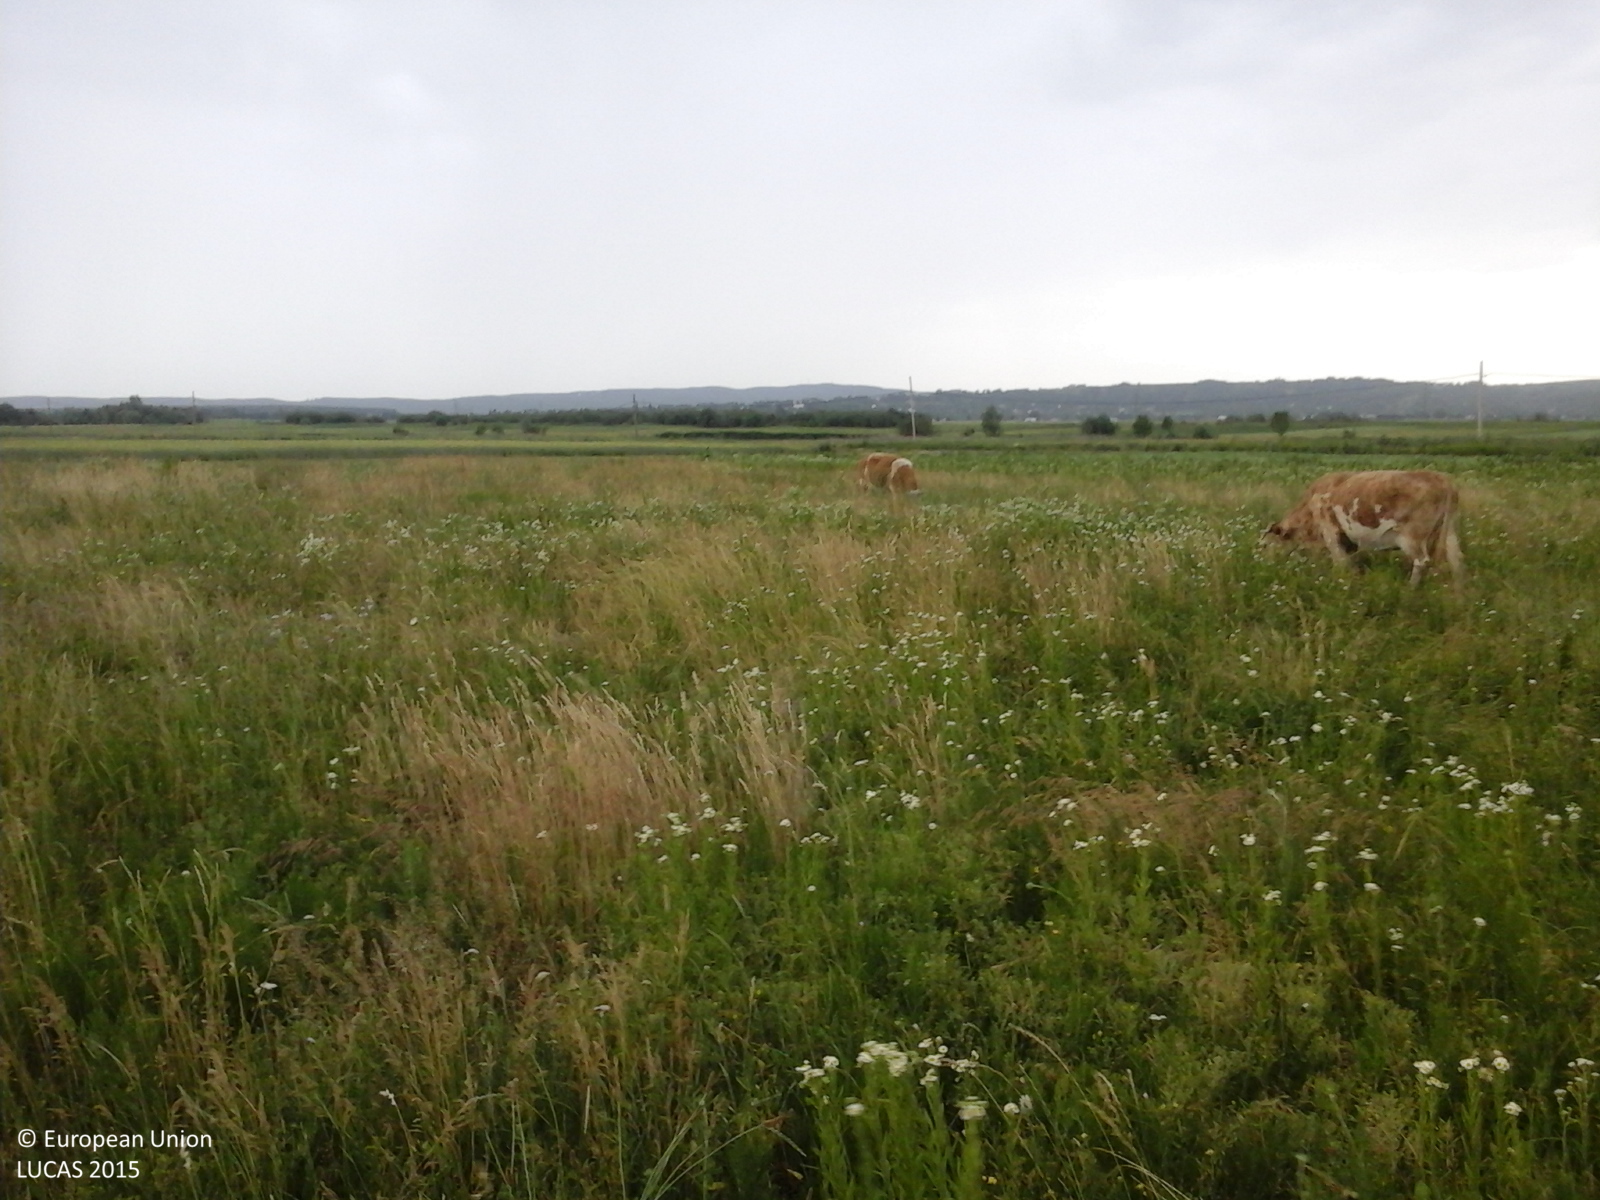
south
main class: Grassland
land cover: Grassland without tree/shrub cover
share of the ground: > 75 %
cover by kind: herbaceous plants 100 %
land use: Agriculture (excluding fallow land and kitchen gardens)
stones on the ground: < 10 %
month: June
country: RO
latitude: 47.2723
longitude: 26.4367
